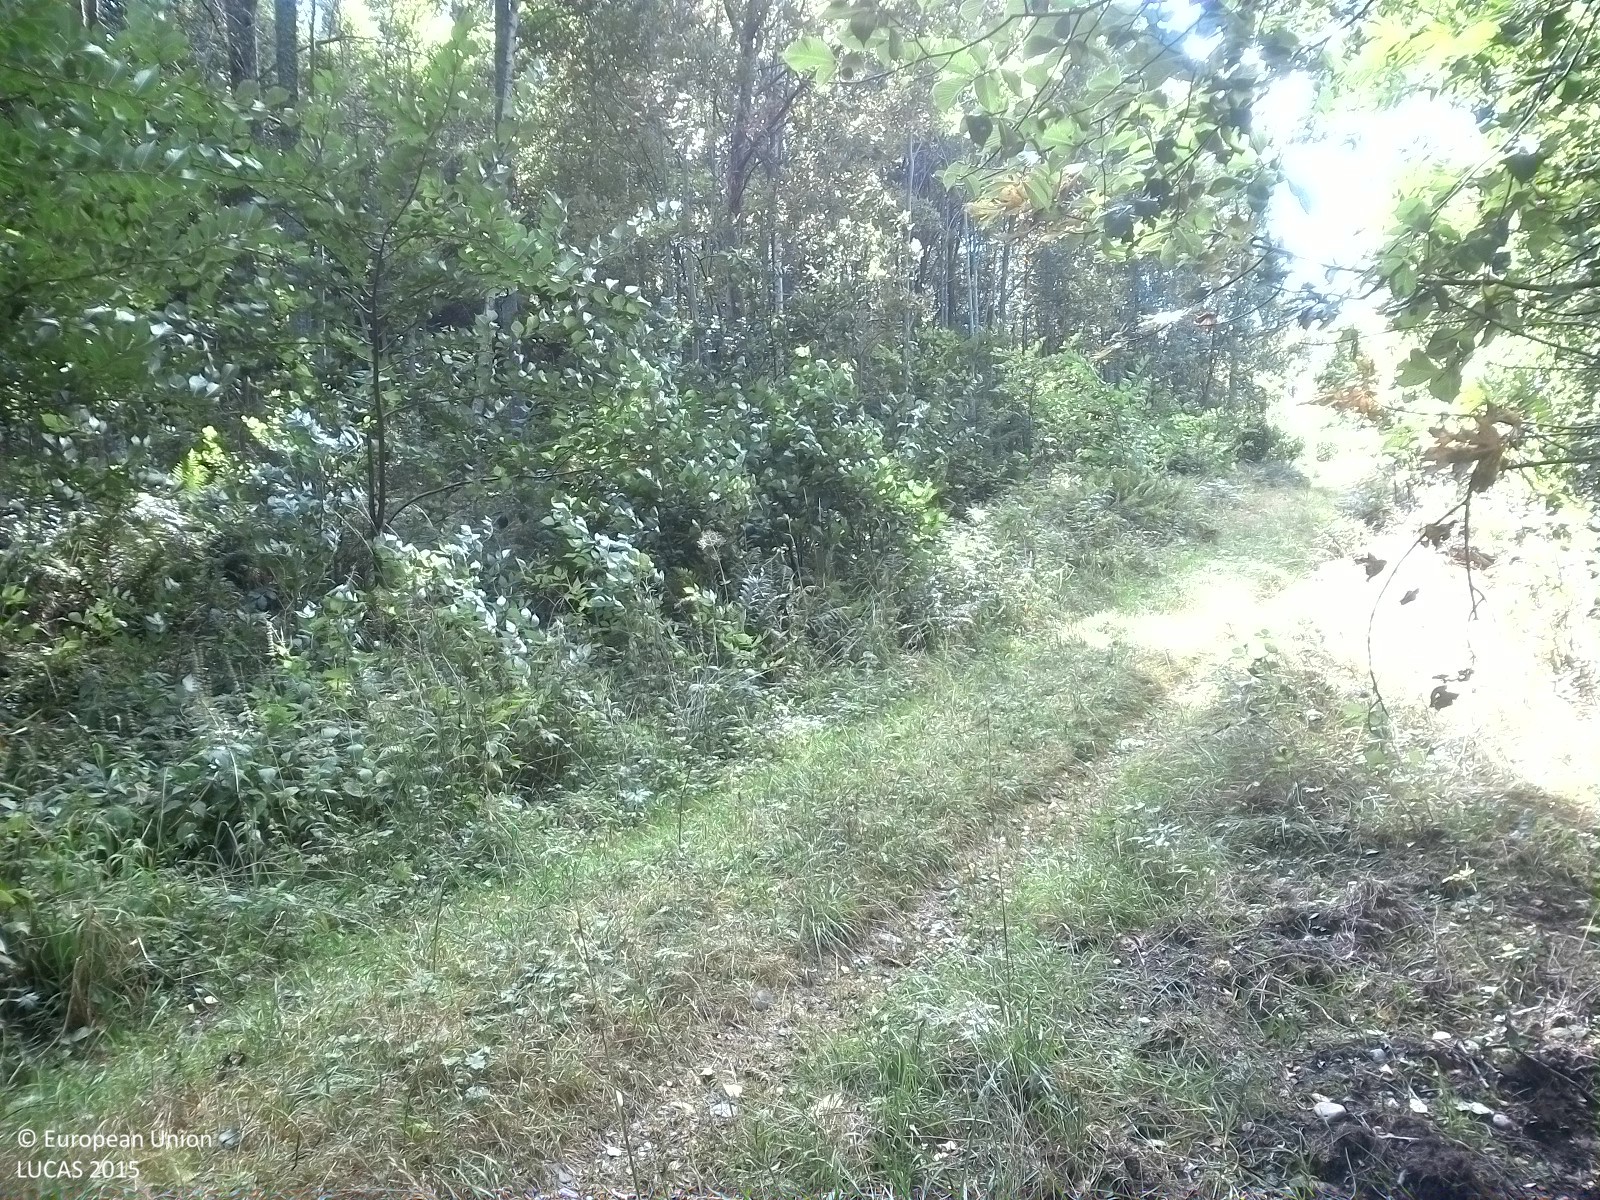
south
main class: Woodland
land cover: Broadleaved woodland
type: hemiboreal forest and nemoral coniferous forest and mixed broadleaved-coniferous forest
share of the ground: 50 - 75 %
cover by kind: broadleaved forest trees 60 %, unconsolidated bare surface 20 %, herbaceous plants 10 %, shrubs 5 %, lichens and mosses 5 %
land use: Forestry
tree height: > 5 m
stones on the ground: 10 - 25 %
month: September
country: SE
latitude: 59.1388
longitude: 15.8477
